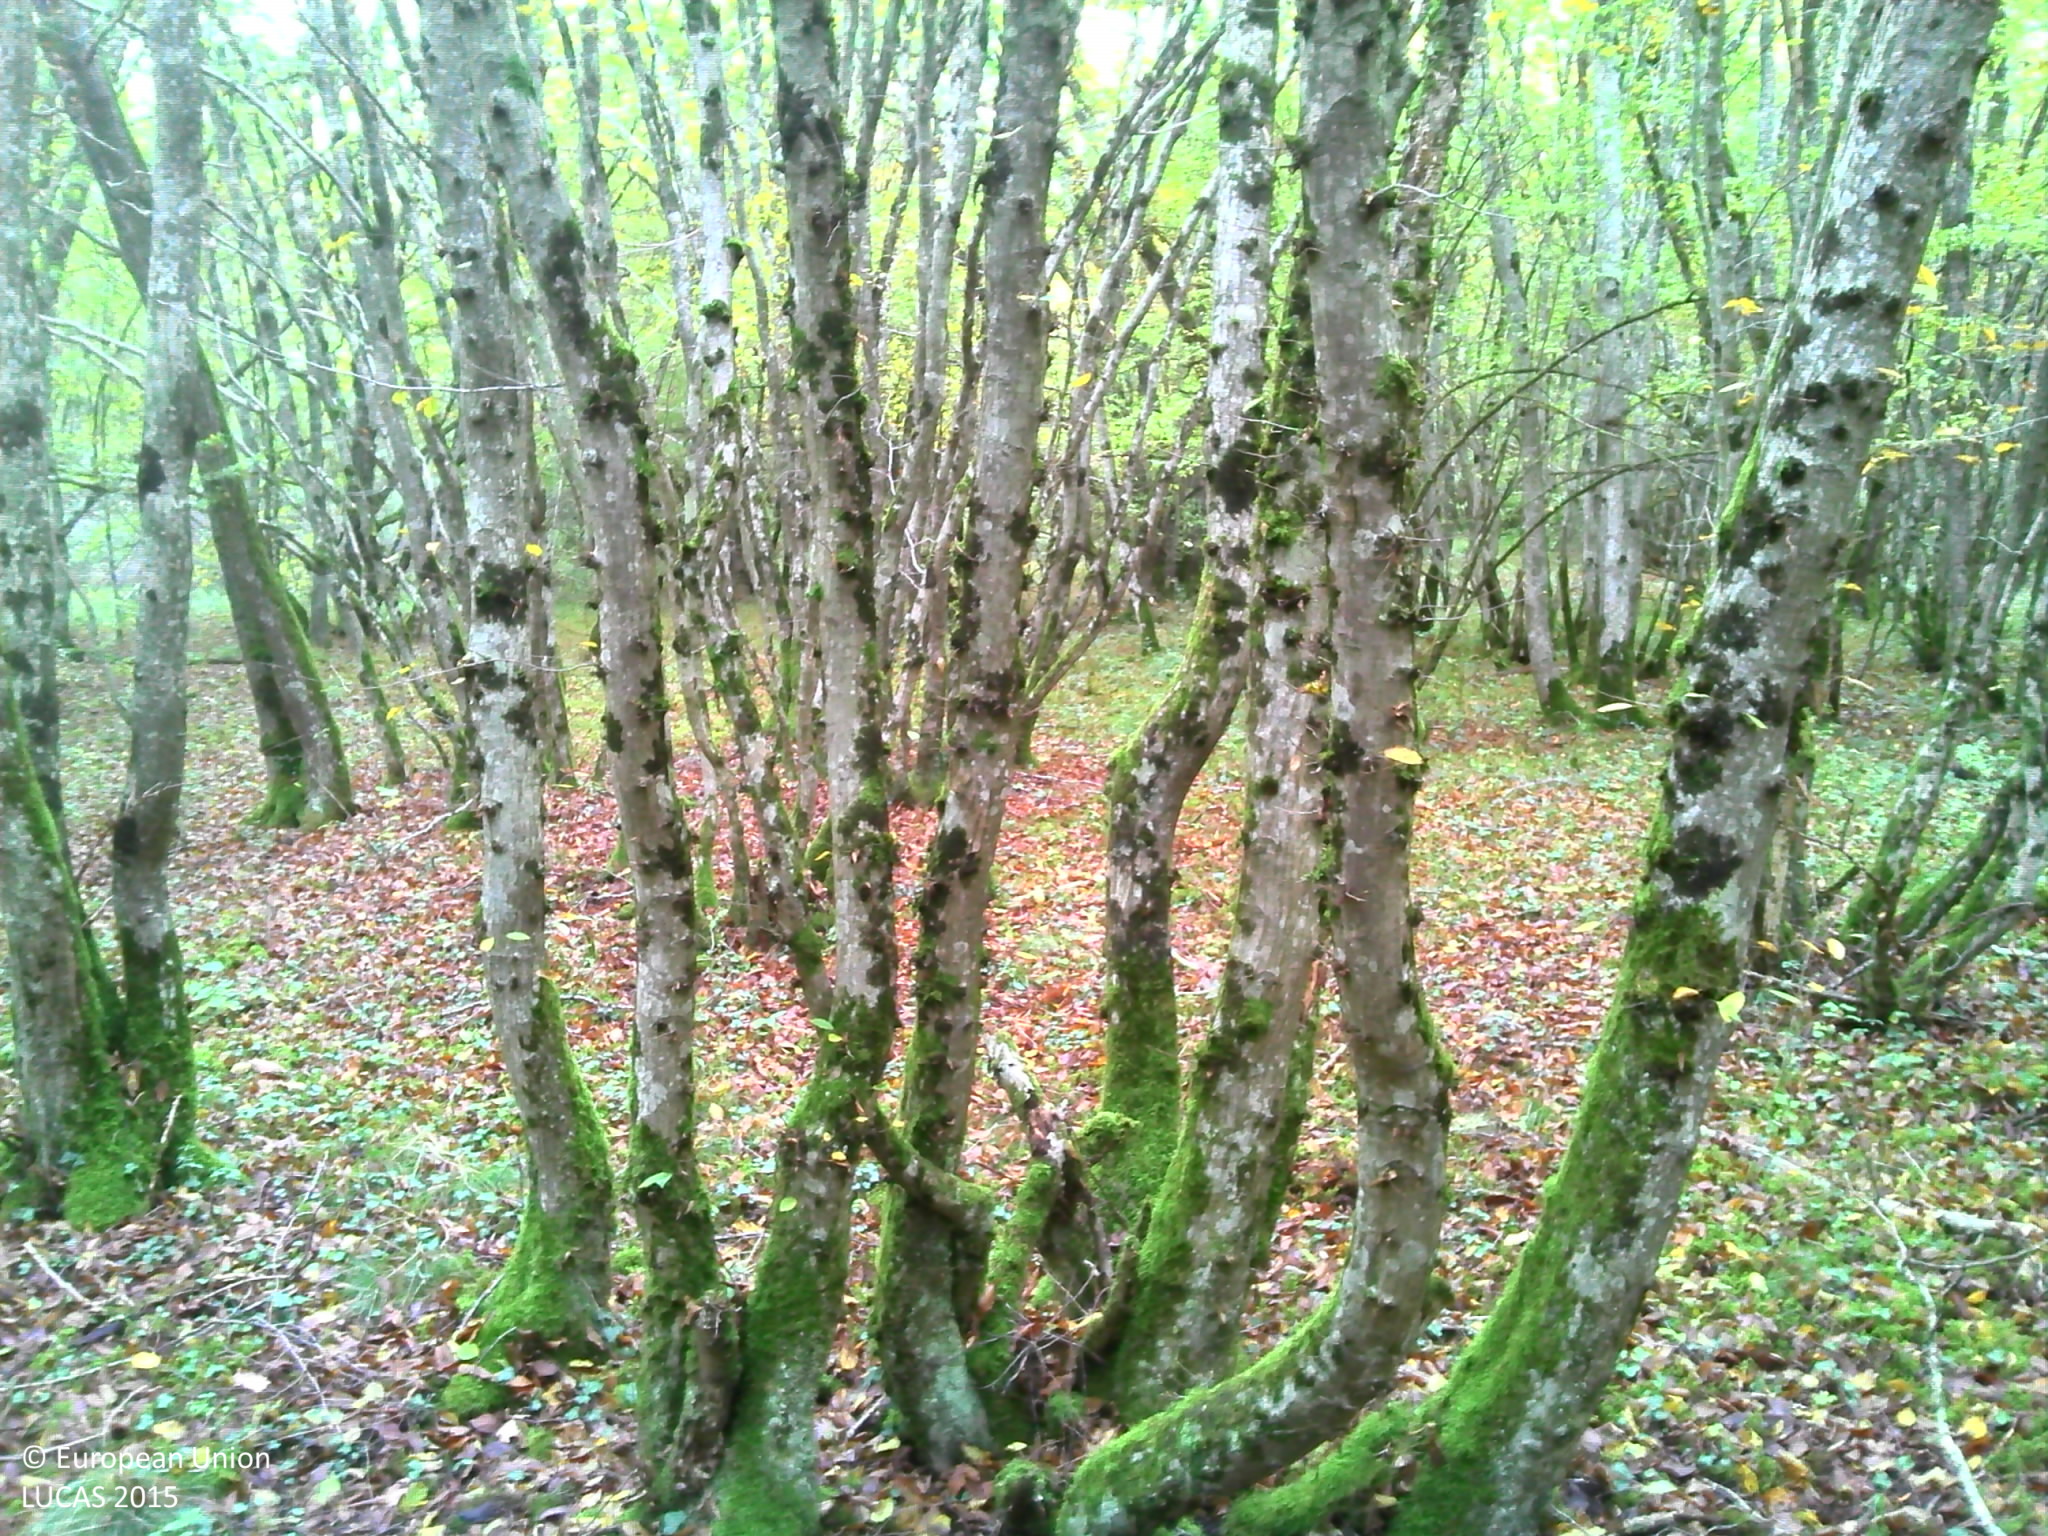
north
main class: Woodland
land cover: Broadleaved woodland
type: mesophytic deciduous forest
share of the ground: > 75 %
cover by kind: broadleaved forest trees 90 %, herbaceous plants 10 %
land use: Forestry
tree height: > 5 m
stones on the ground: < 10 %
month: October
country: FR
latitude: 47.5328
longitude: 4.9921
